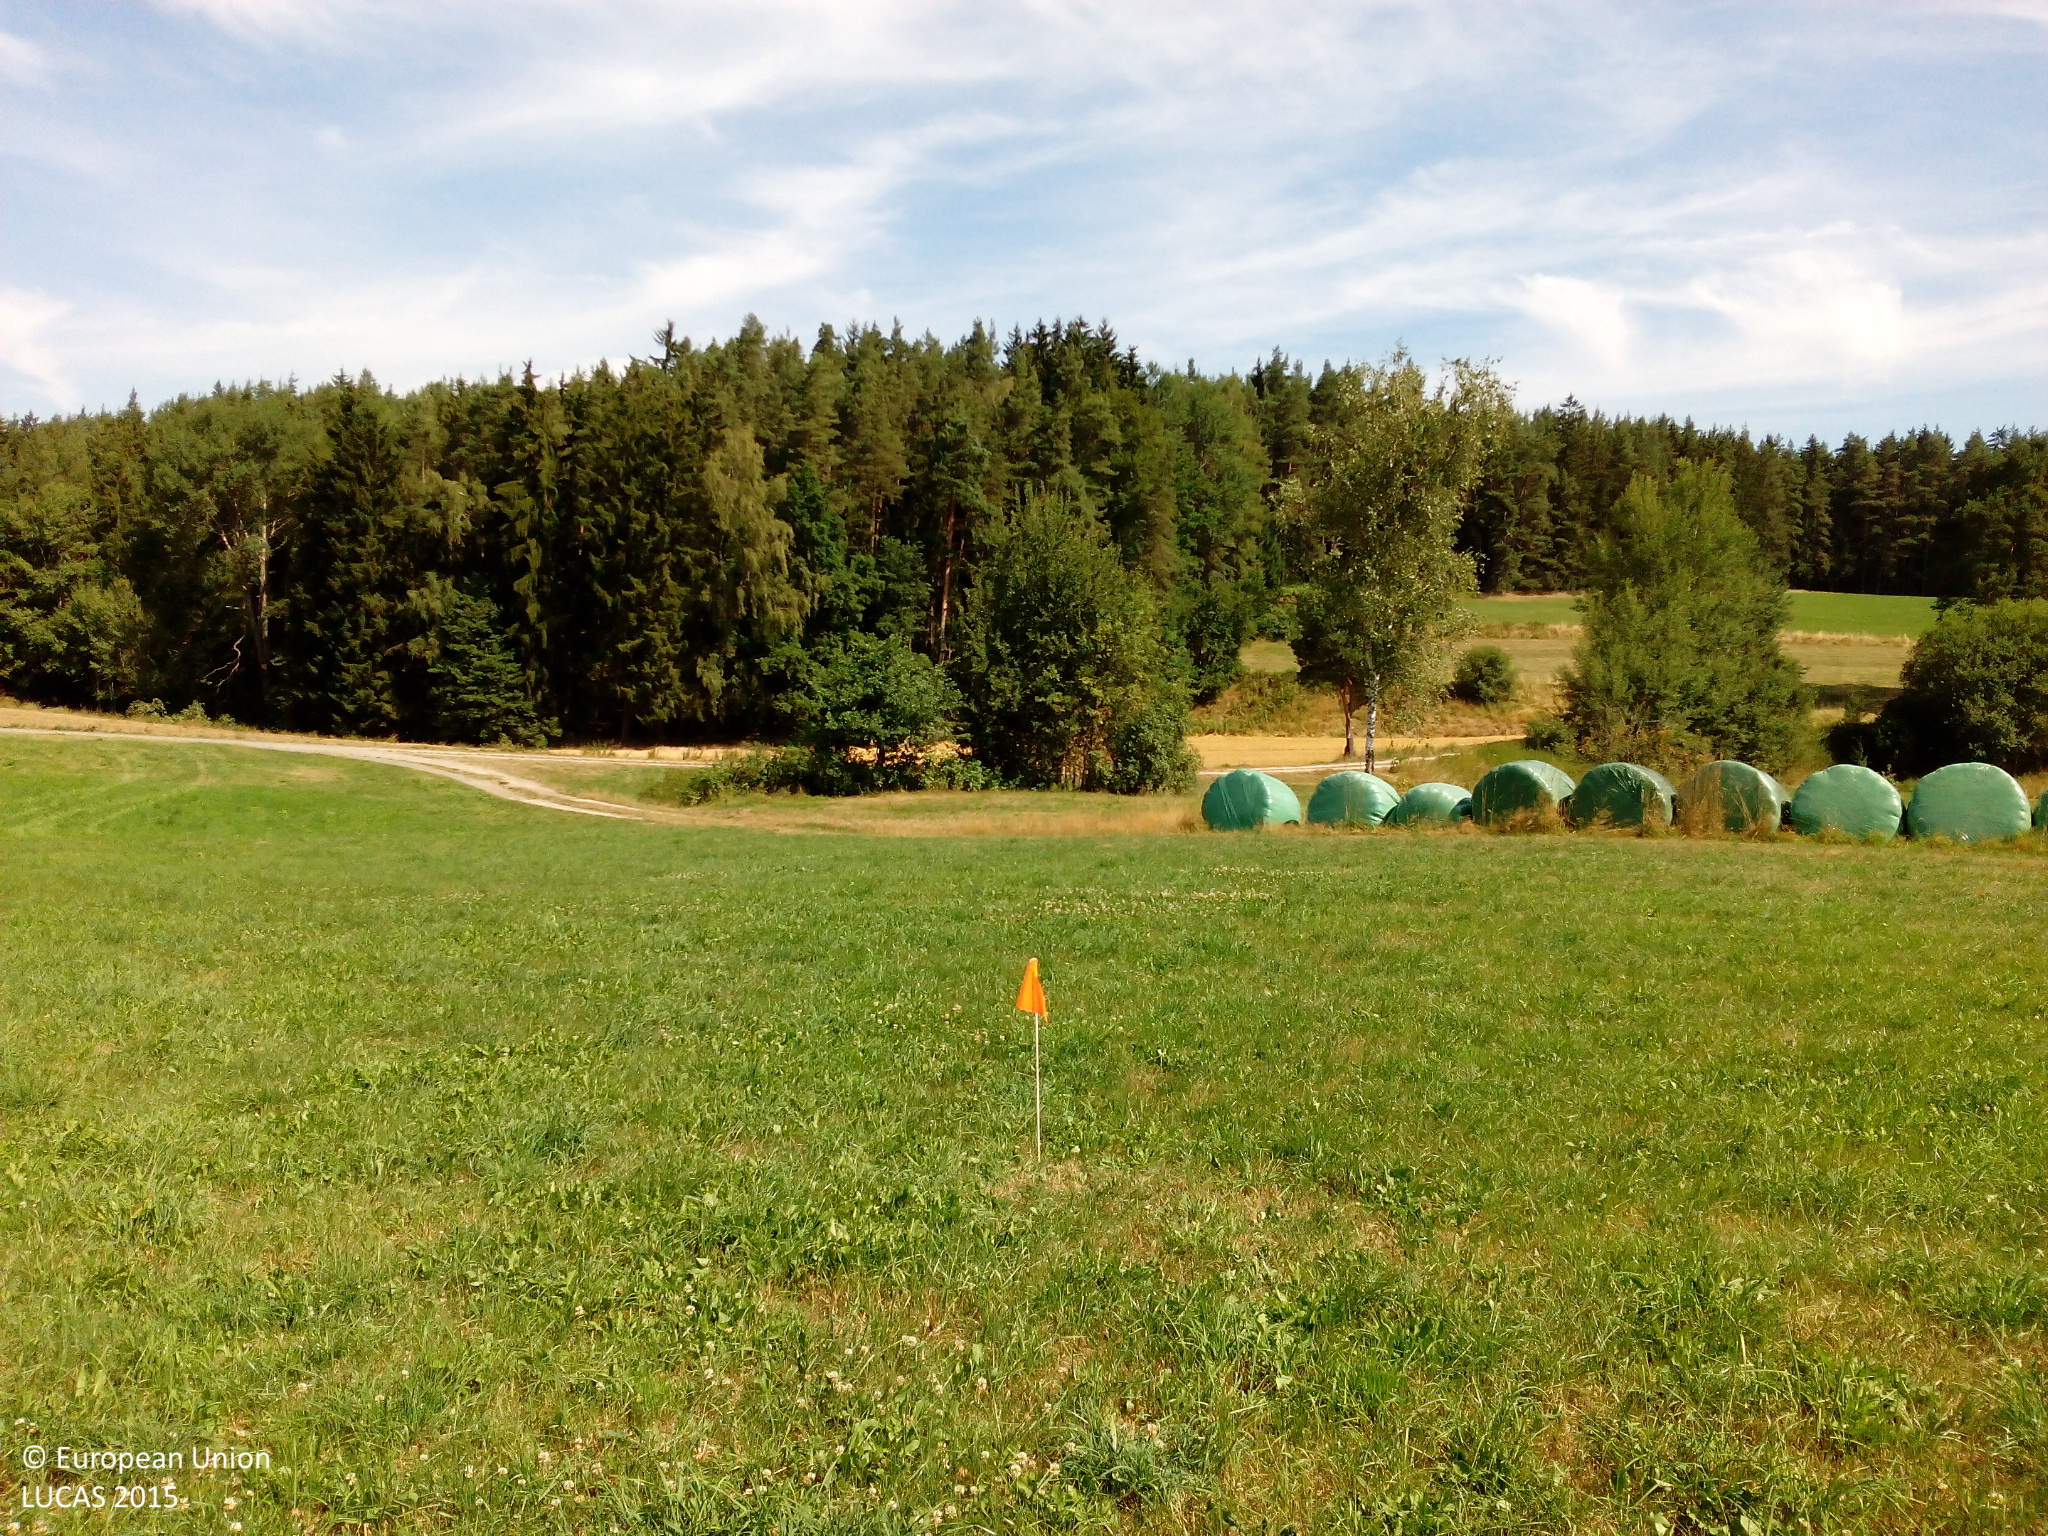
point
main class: Grassland
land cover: Grassland without tree/shrub cover
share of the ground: > 75 %
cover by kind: herbaceous plants 85 %, unconsolidated bare surface 10 %
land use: Agriculture (excluding fallow land and kitchen gardens)
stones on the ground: < 10 %
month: August
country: DE
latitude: 49.8564
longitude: 12.2390
